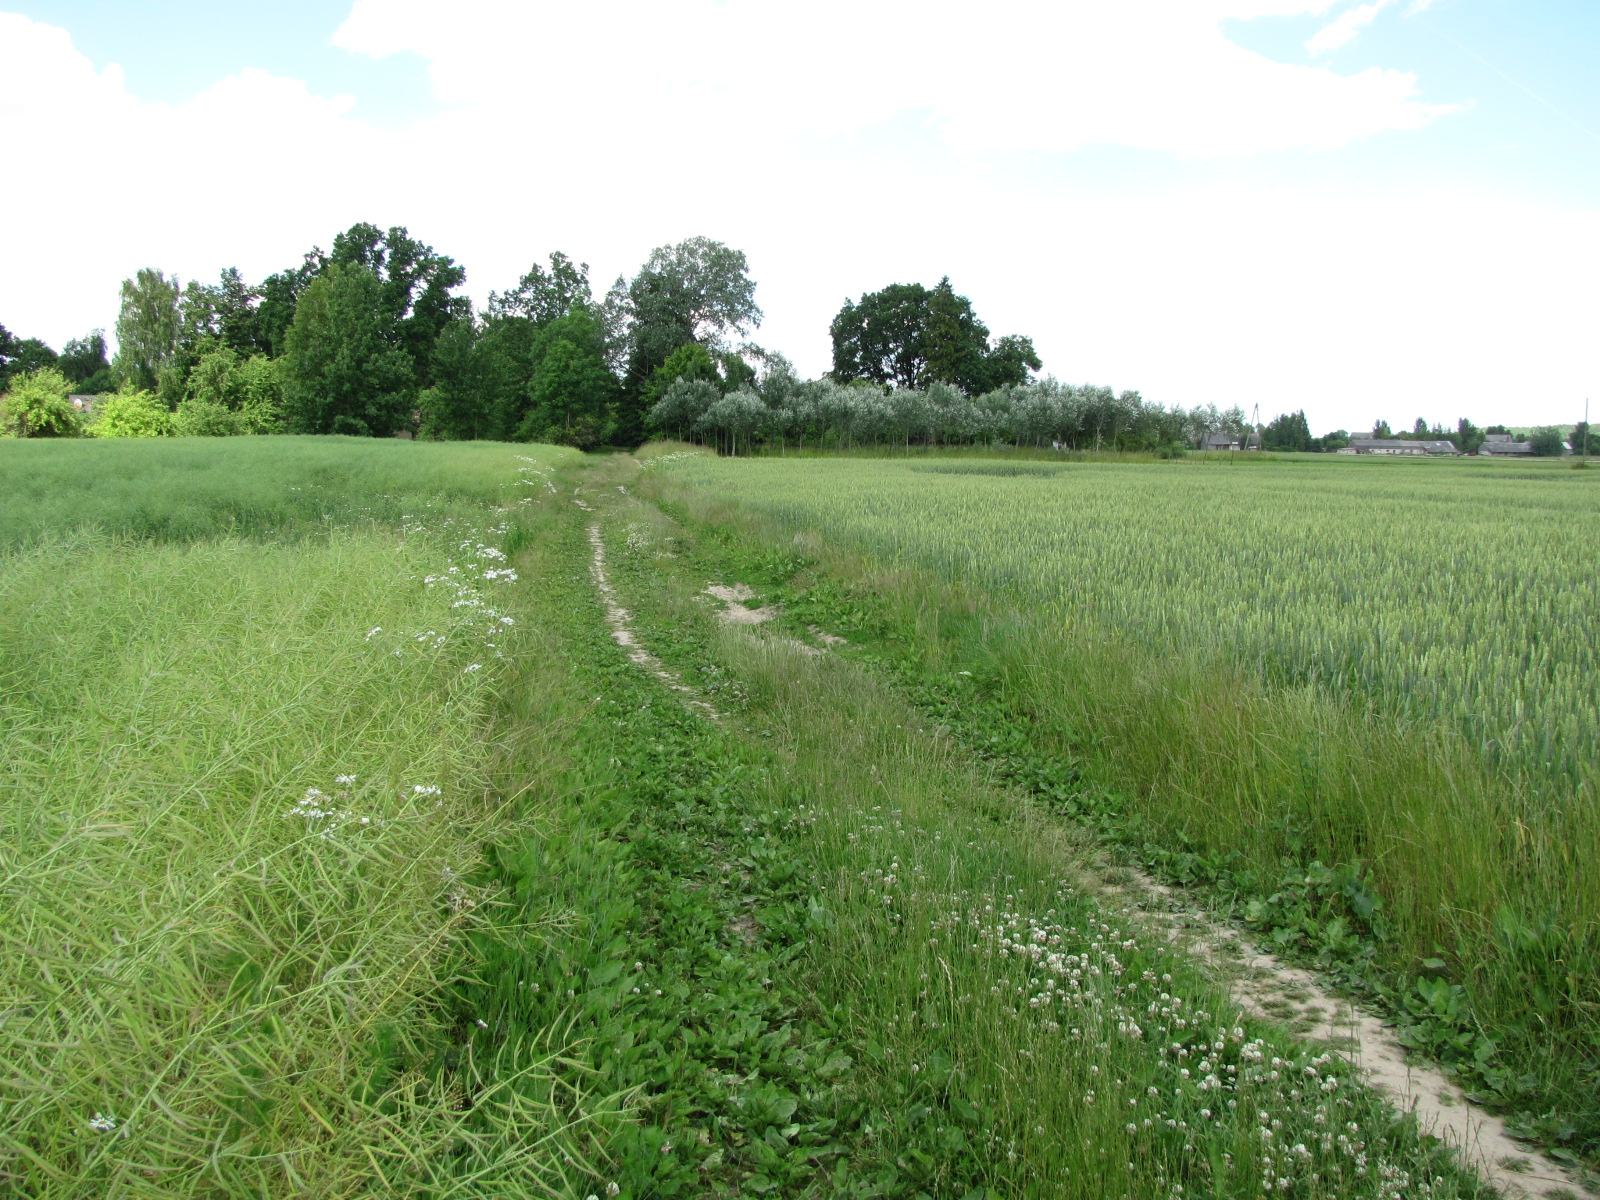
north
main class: Cropland
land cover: Rape and turnip rape
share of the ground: > 75 %
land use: Agriculture (excluding fallow land and kitchen gardens)
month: June
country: LV
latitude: 56.4298
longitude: 23.9154
